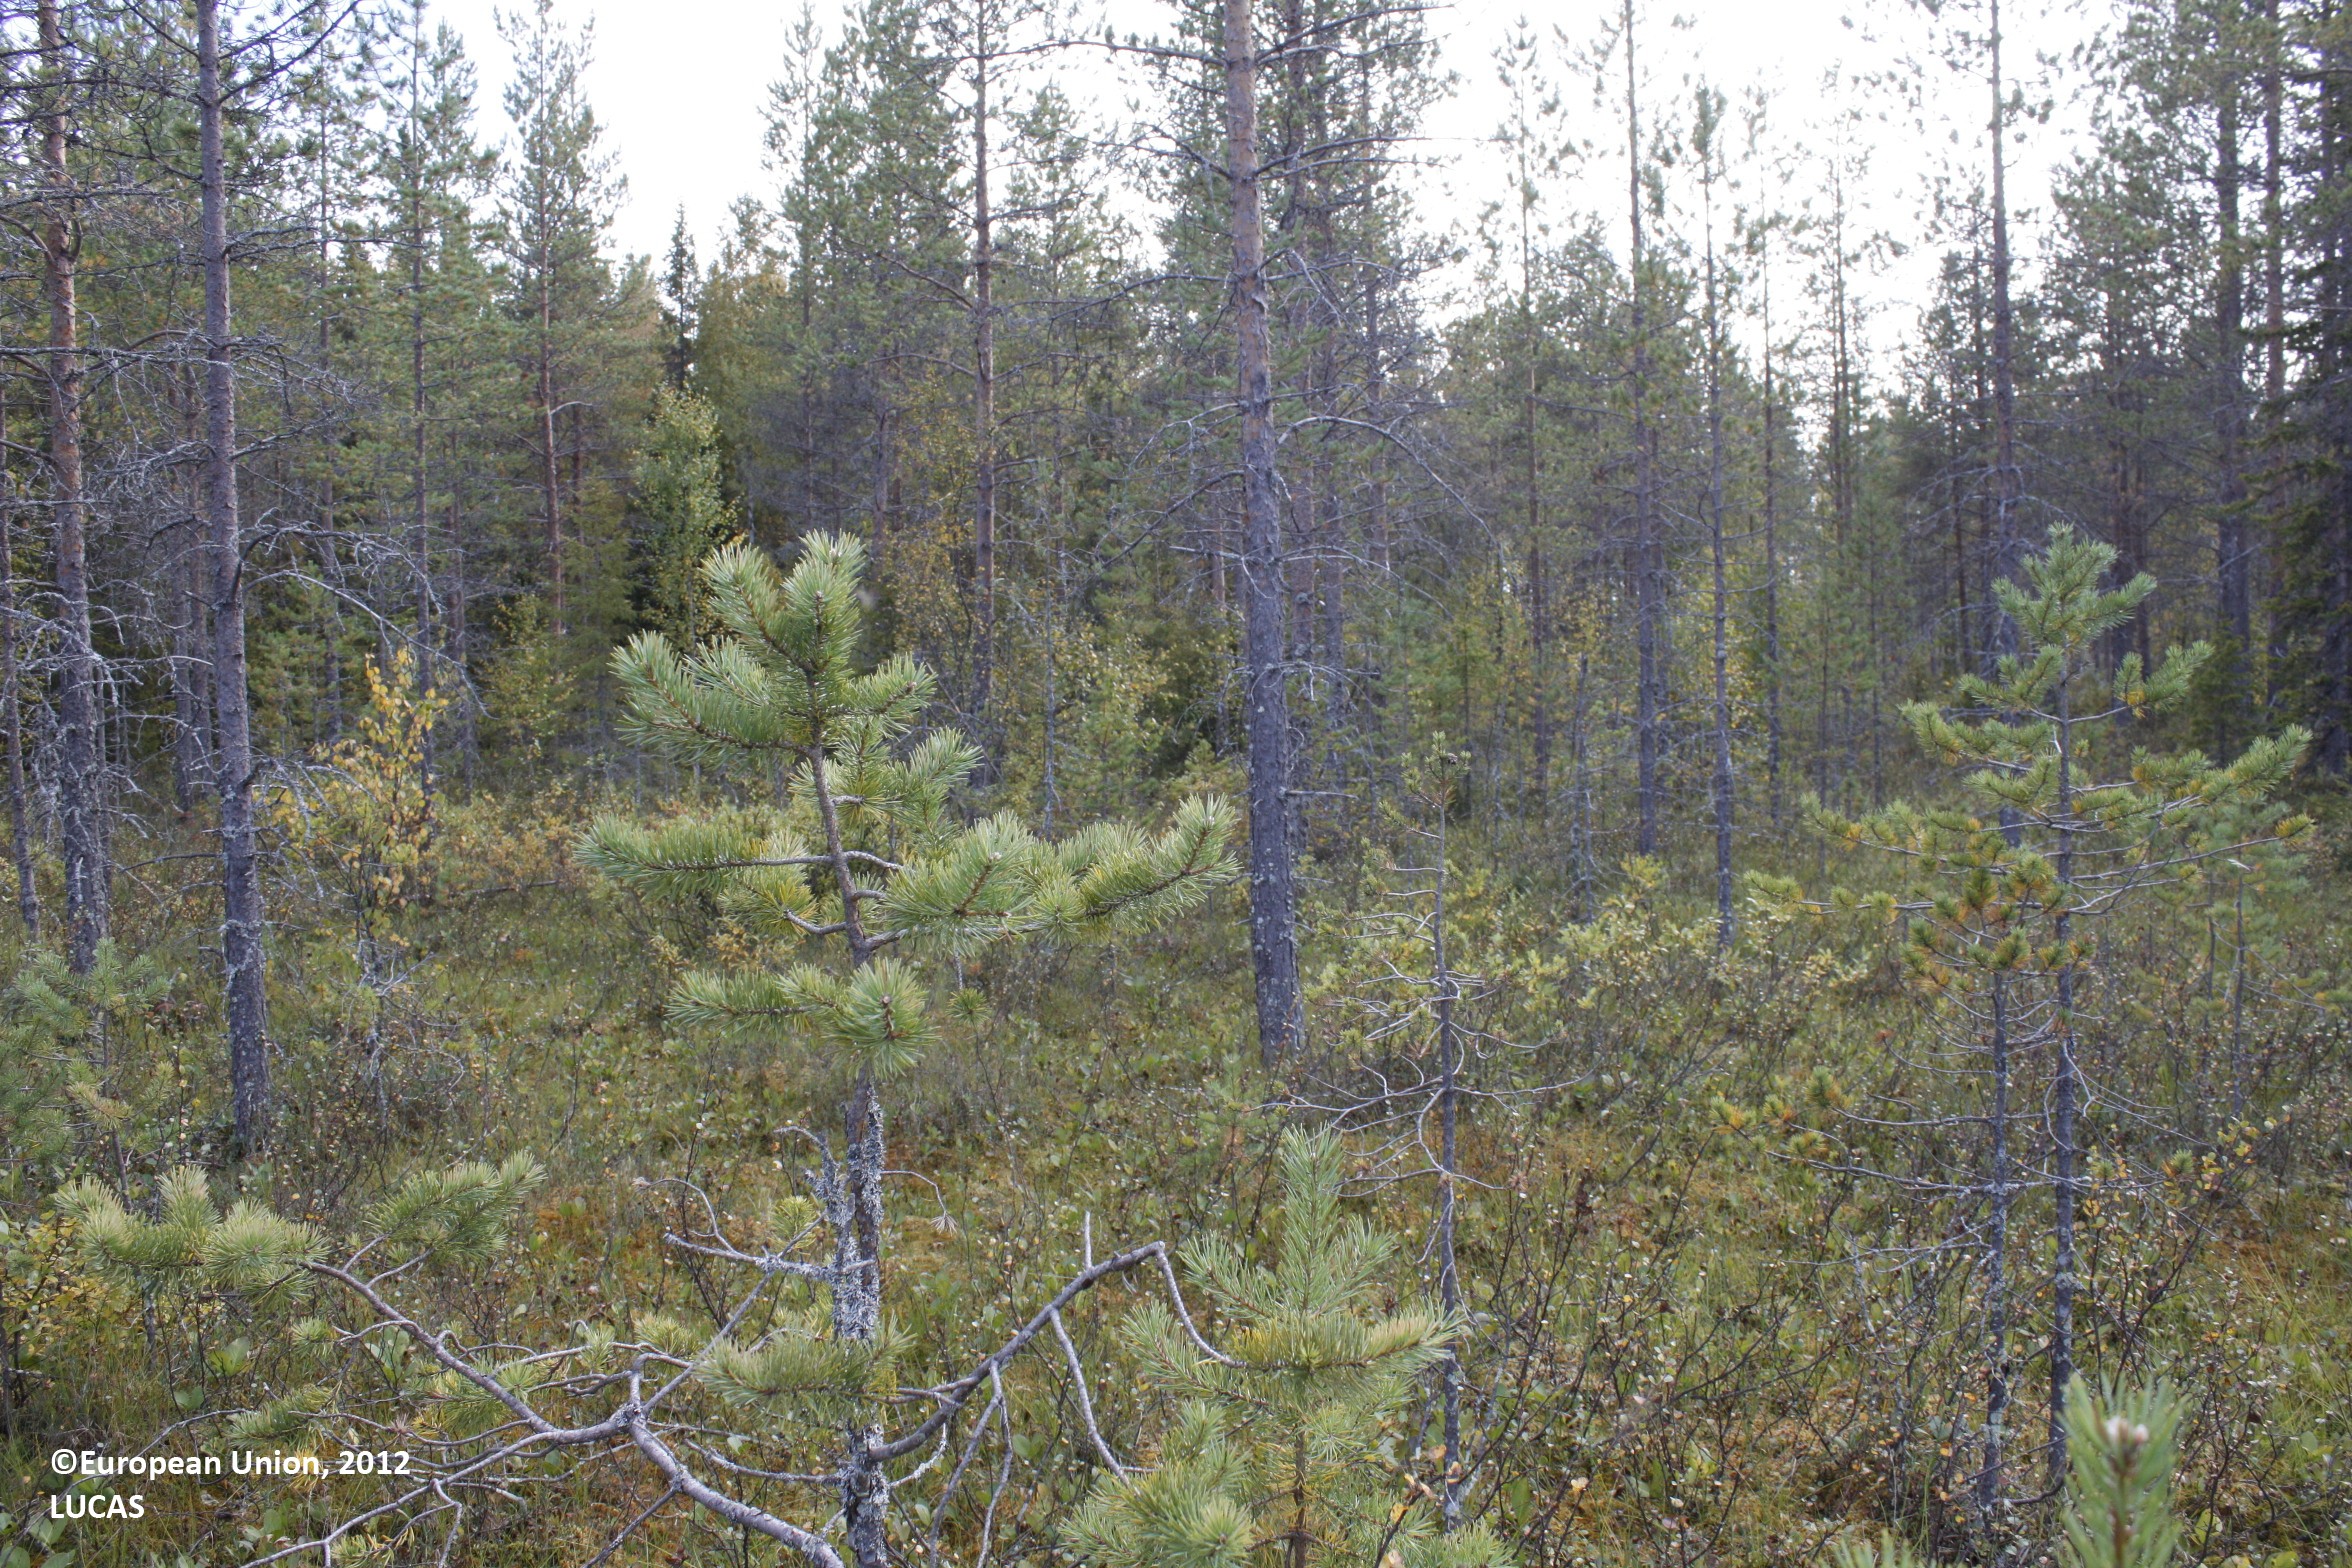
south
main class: Woodland
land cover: Pine dominated coniferous woodland
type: mire and swamp forests
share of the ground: 25 - 50 %
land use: Semi-natural and natural areas not in use
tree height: > 5 m
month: September
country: FI
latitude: 65.4144
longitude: 27.2479
